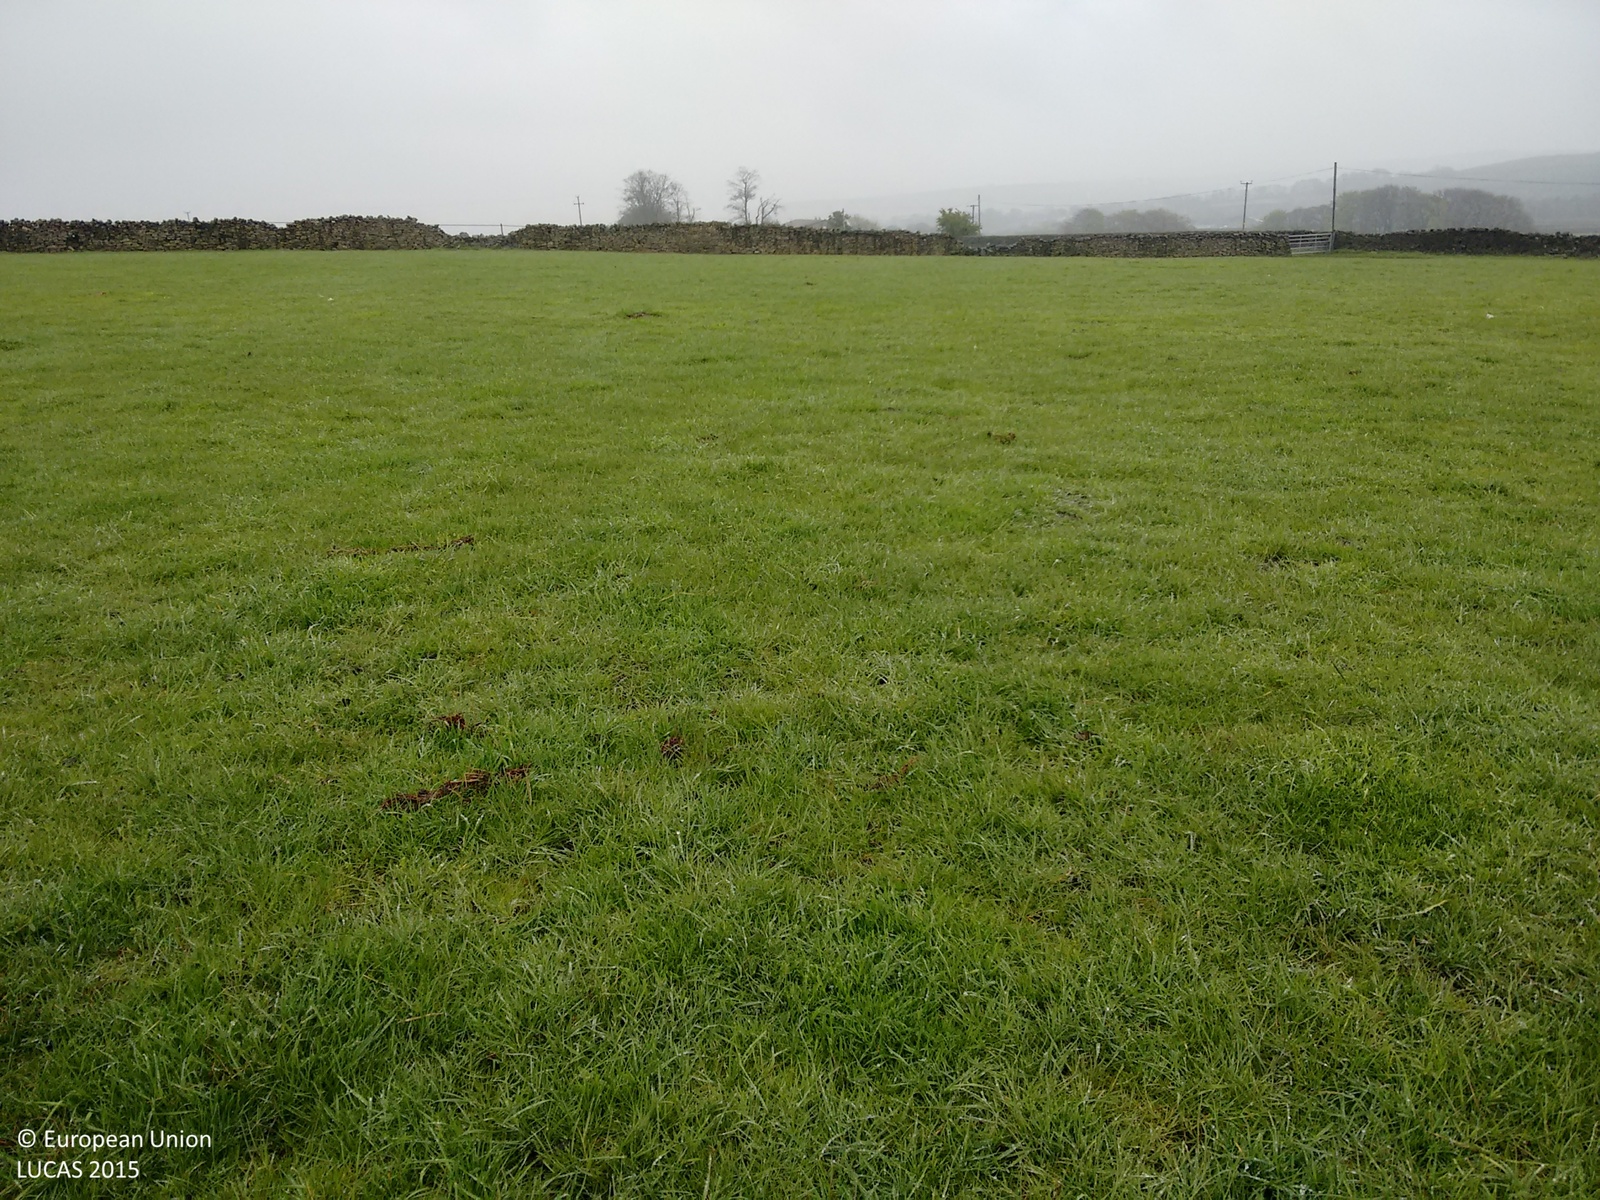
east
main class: Grassland
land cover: Grassland without tree/shrub cover
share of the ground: > 75 %
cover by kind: herbaceous plants 100 %
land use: Agriculture (excluding fallow land and kitchen gardens)
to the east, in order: Grassland without tree/shrub cover; Dry stone walls; Grassland without tree/shrub cover; Dry stone walls; Grassland without tree/shrub cover; Electric lines; Grassland without tree/shrub cover
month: May
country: GB
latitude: 53.8288
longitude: -1.9218
